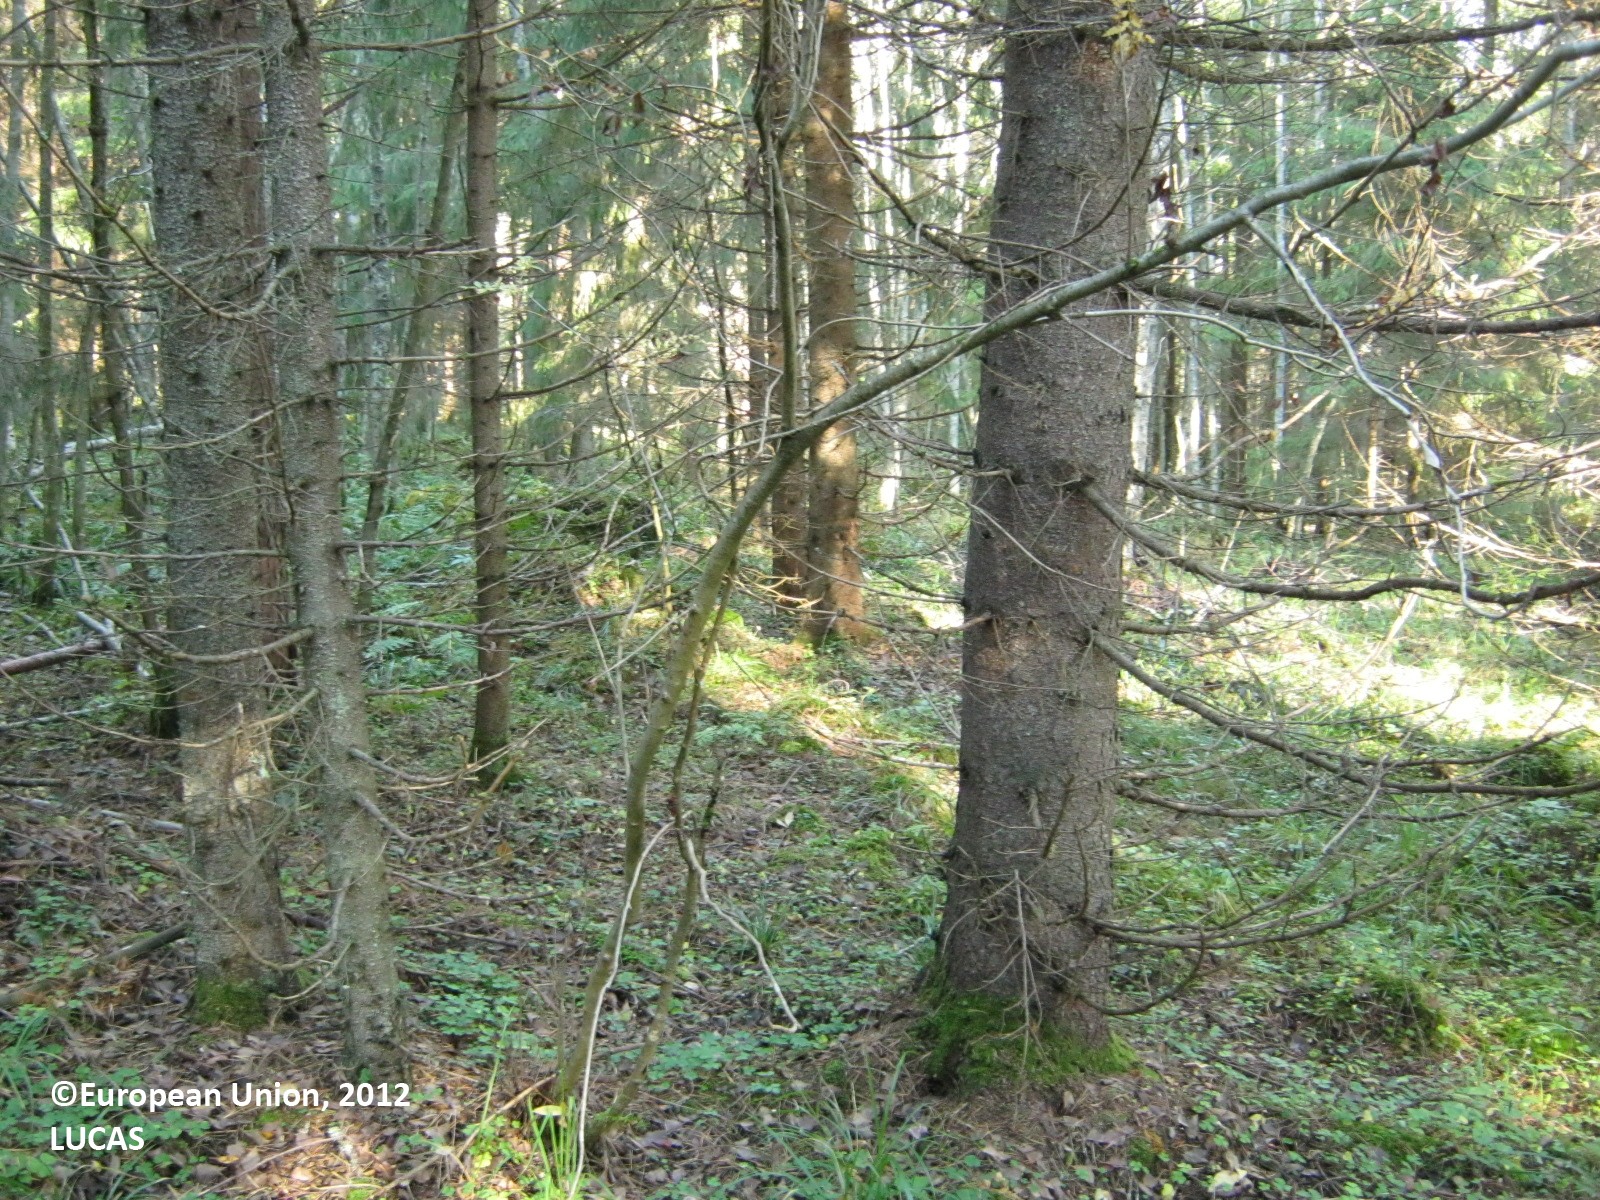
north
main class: Woodland
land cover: Spruce dominated mixed woodland
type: boreal forest
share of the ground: 50 - 75 %
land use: Forestry
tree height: > 5 m
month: September
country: FI
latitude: 62.5227
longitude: 27.7972
